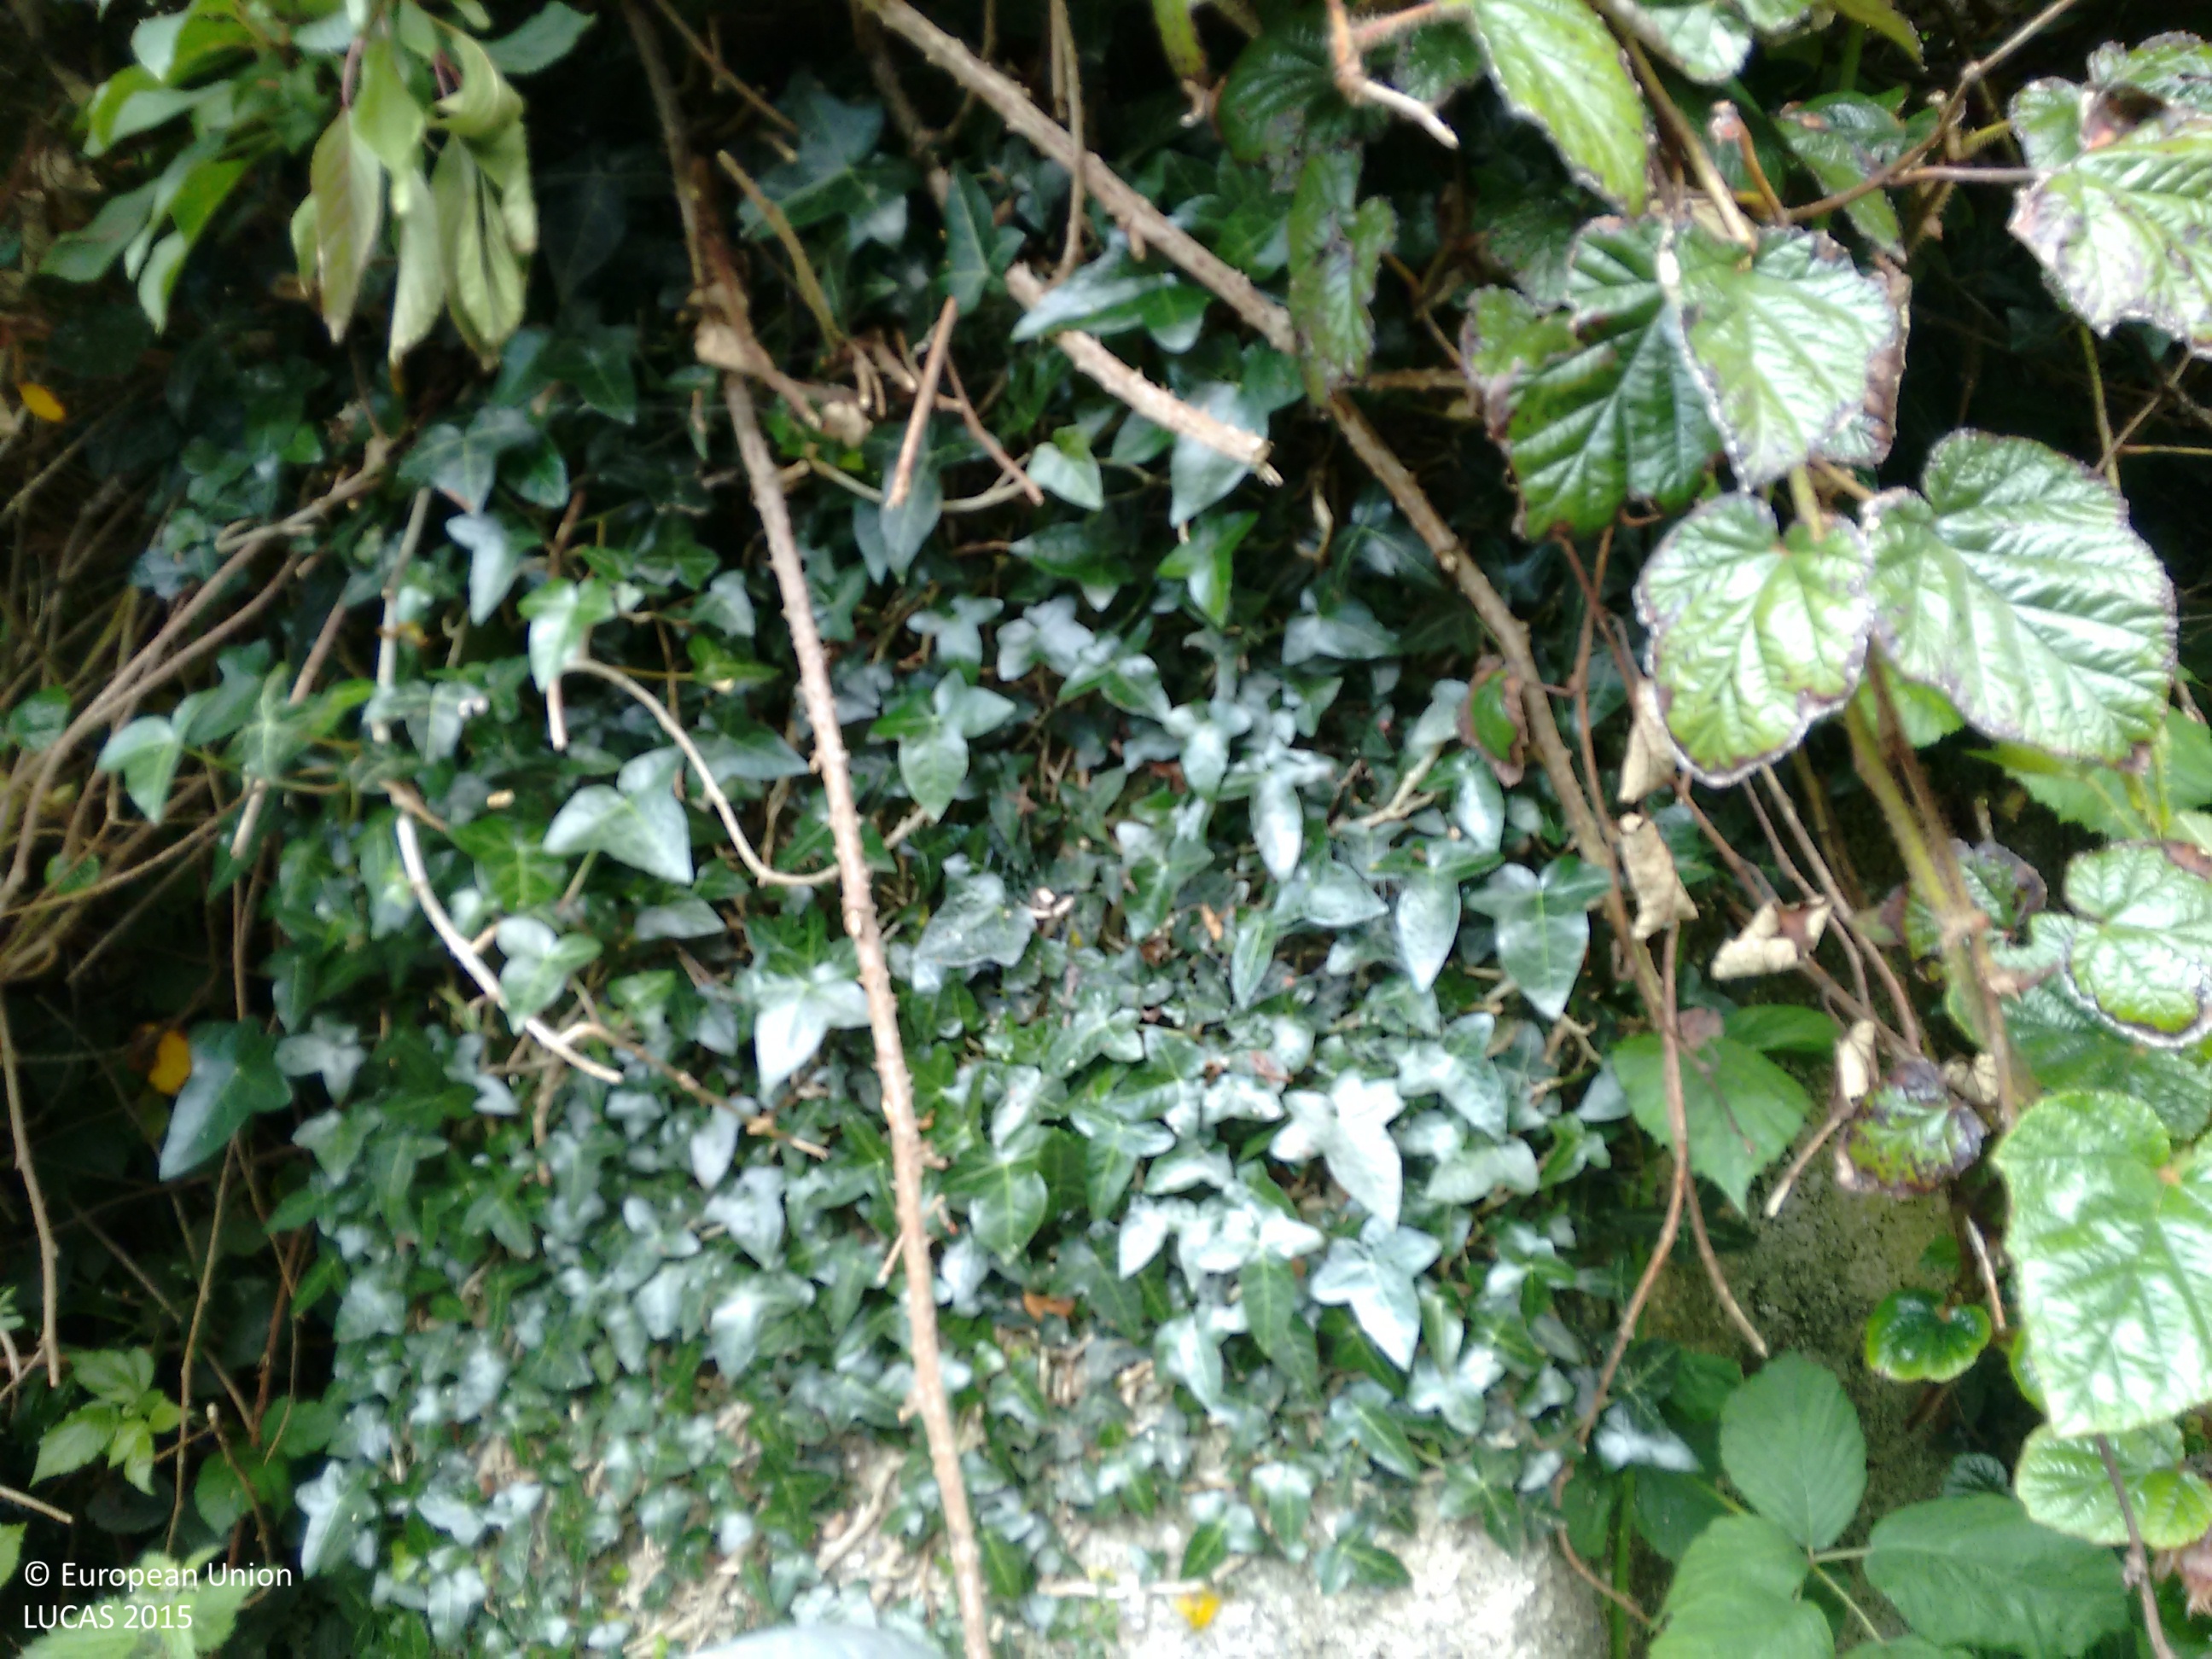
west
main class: Grassland
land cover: Grassland without tree/shrub cover
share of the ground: > 75 %
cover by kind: herbaceous plants 100 %
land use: Agriculture (excluding fallow land and kitchen gardens)
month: July
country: IE
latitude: 52.5999
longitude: -7.5683
